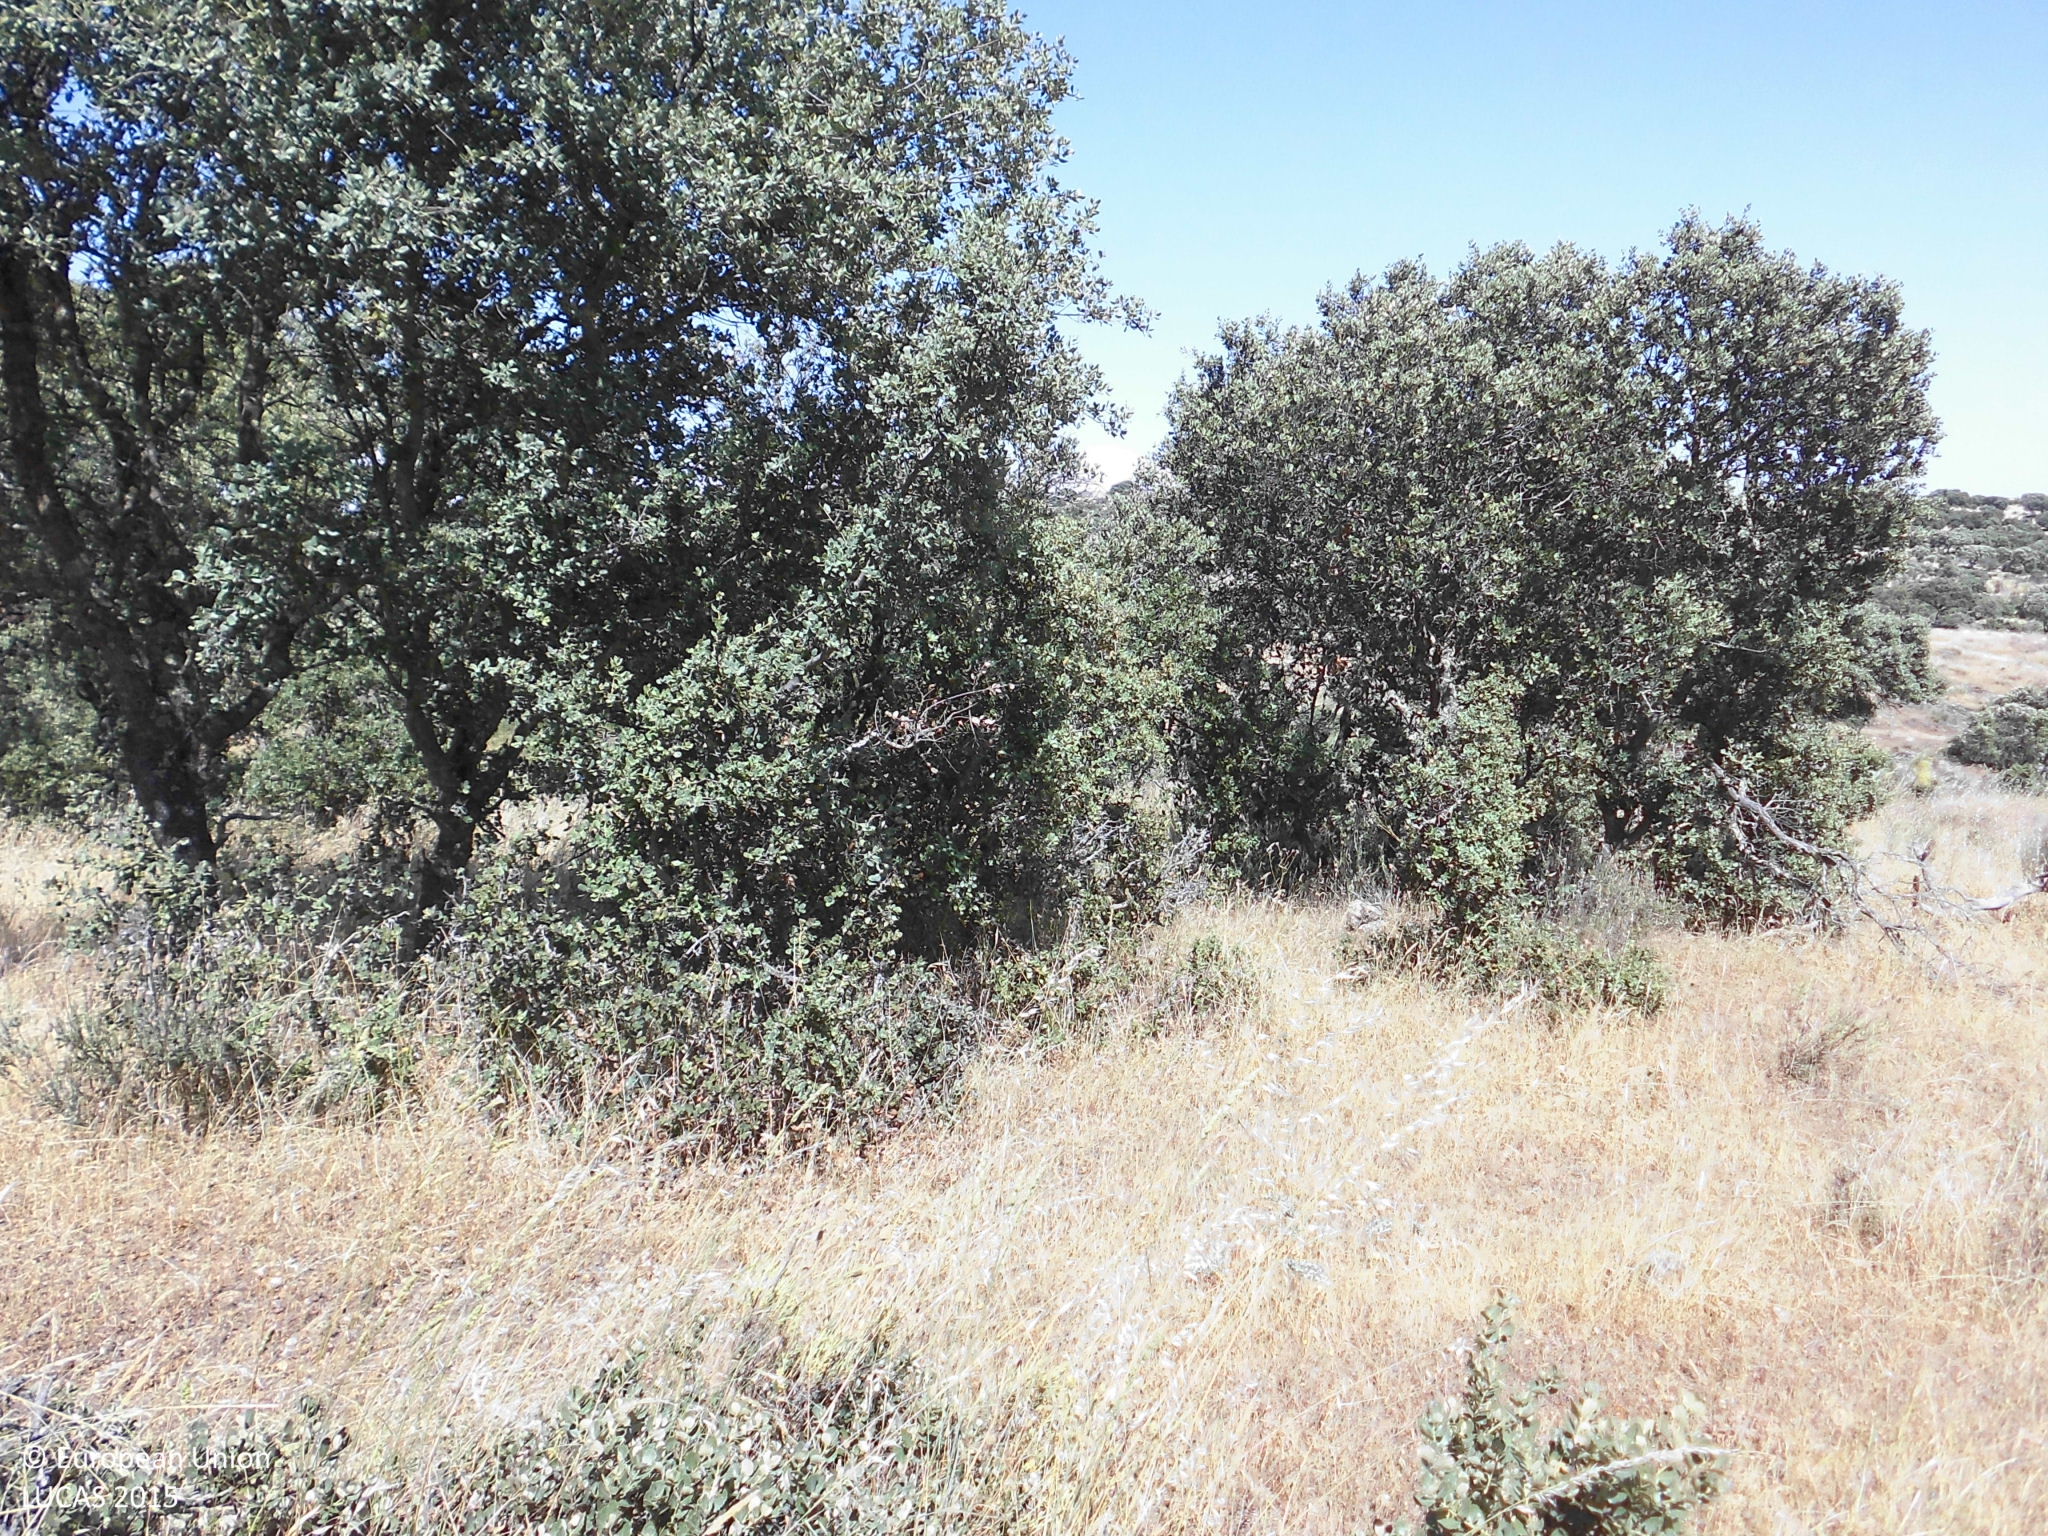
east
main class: Woodland
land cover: Broadleaved woodland
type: broadleaved evergreen forest
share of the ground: 25 - 50 %
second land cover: Grassland without tree/shrub cover
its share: > 75 %
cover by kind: herbaceous plants 55 %, broadleaved forest trees 30 %, shrubs 15 %
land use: Forestry
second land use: Agriculture (excluding fallow land and kitchen gardens)
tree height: > 5 m
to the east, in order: Broadleaved woodland; Grassland without tree/shrub cover; Broadleaved woodland; Ponds and wetlands; Grassland without tree/shrub cover; Fences; Tracks; Fences; Broadleaved woodland; Fences; Grass margins; Tracks; Broadleaved woodland
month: May
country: ES
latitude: 39.3611
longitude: -6.0408
